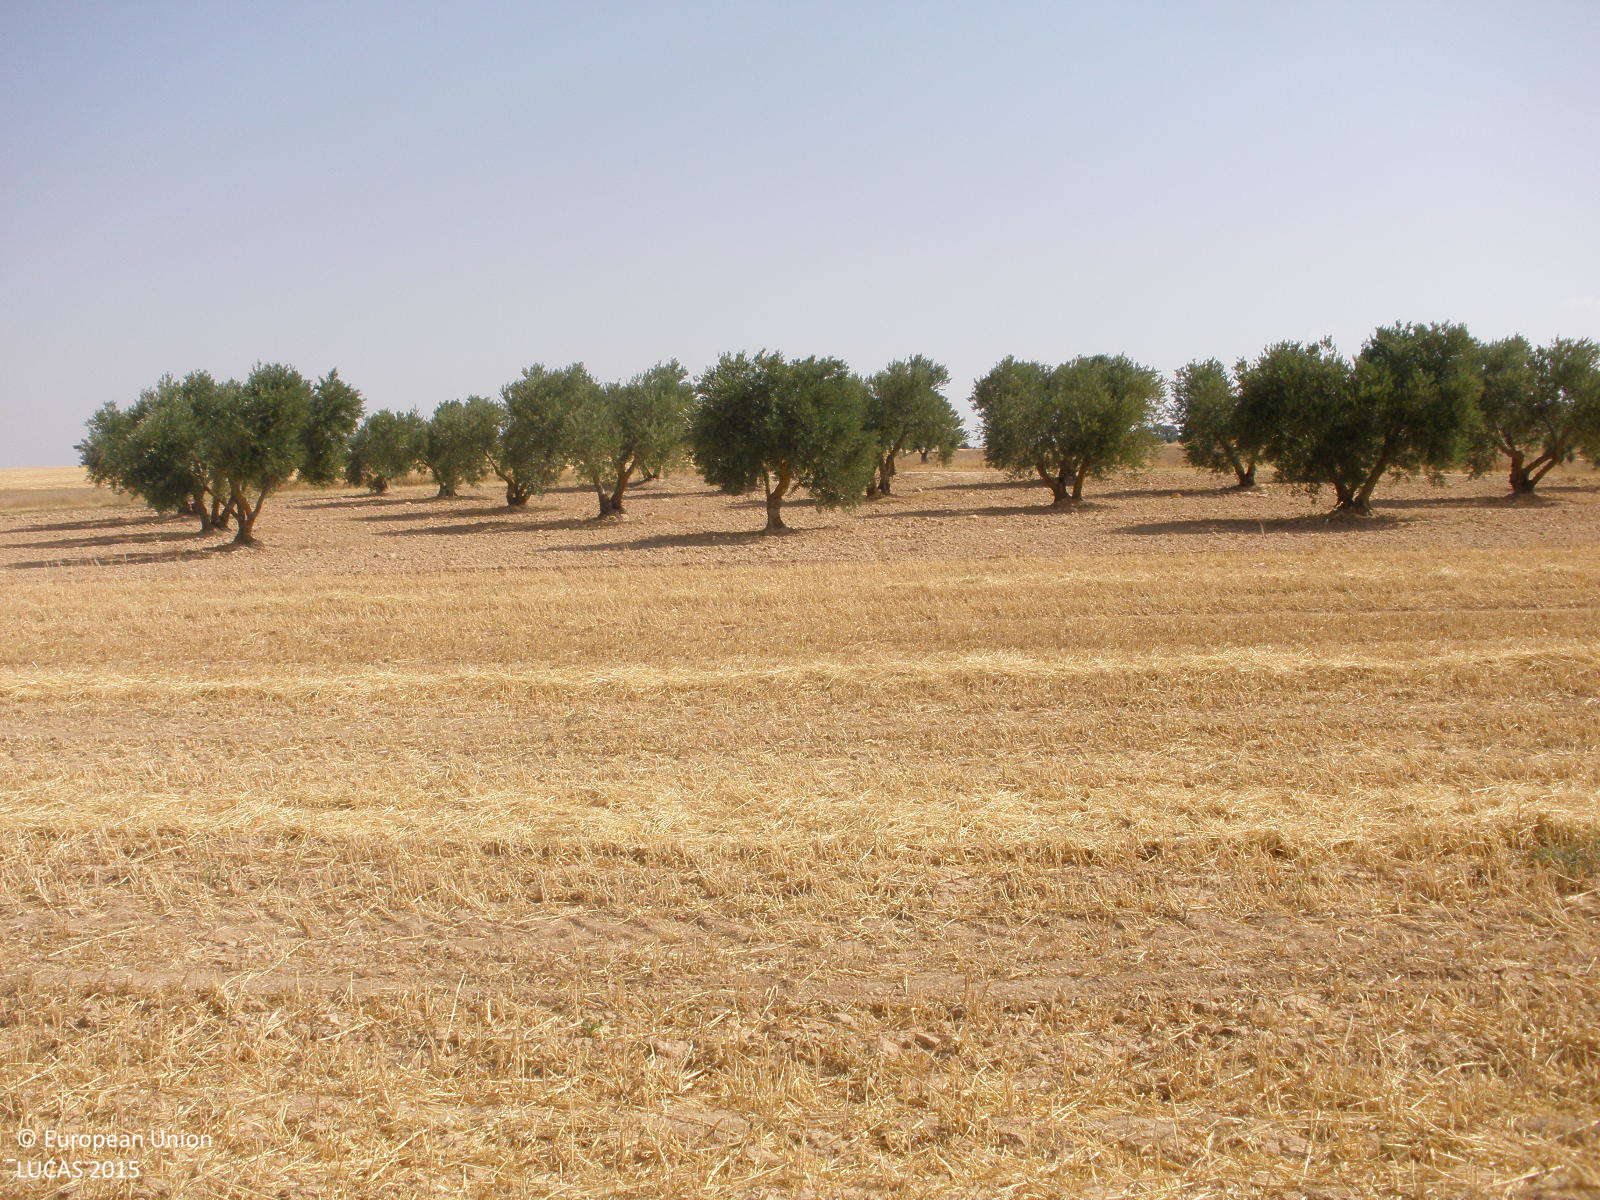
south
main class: Cropland
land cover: Barley
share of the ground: < 10 %
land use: Agriculture (excluding fallow land and kitchen gardens)
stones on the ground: < 10 %
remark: Harvested field
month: July
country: ES
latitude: 40.0132
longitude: -3.3246
